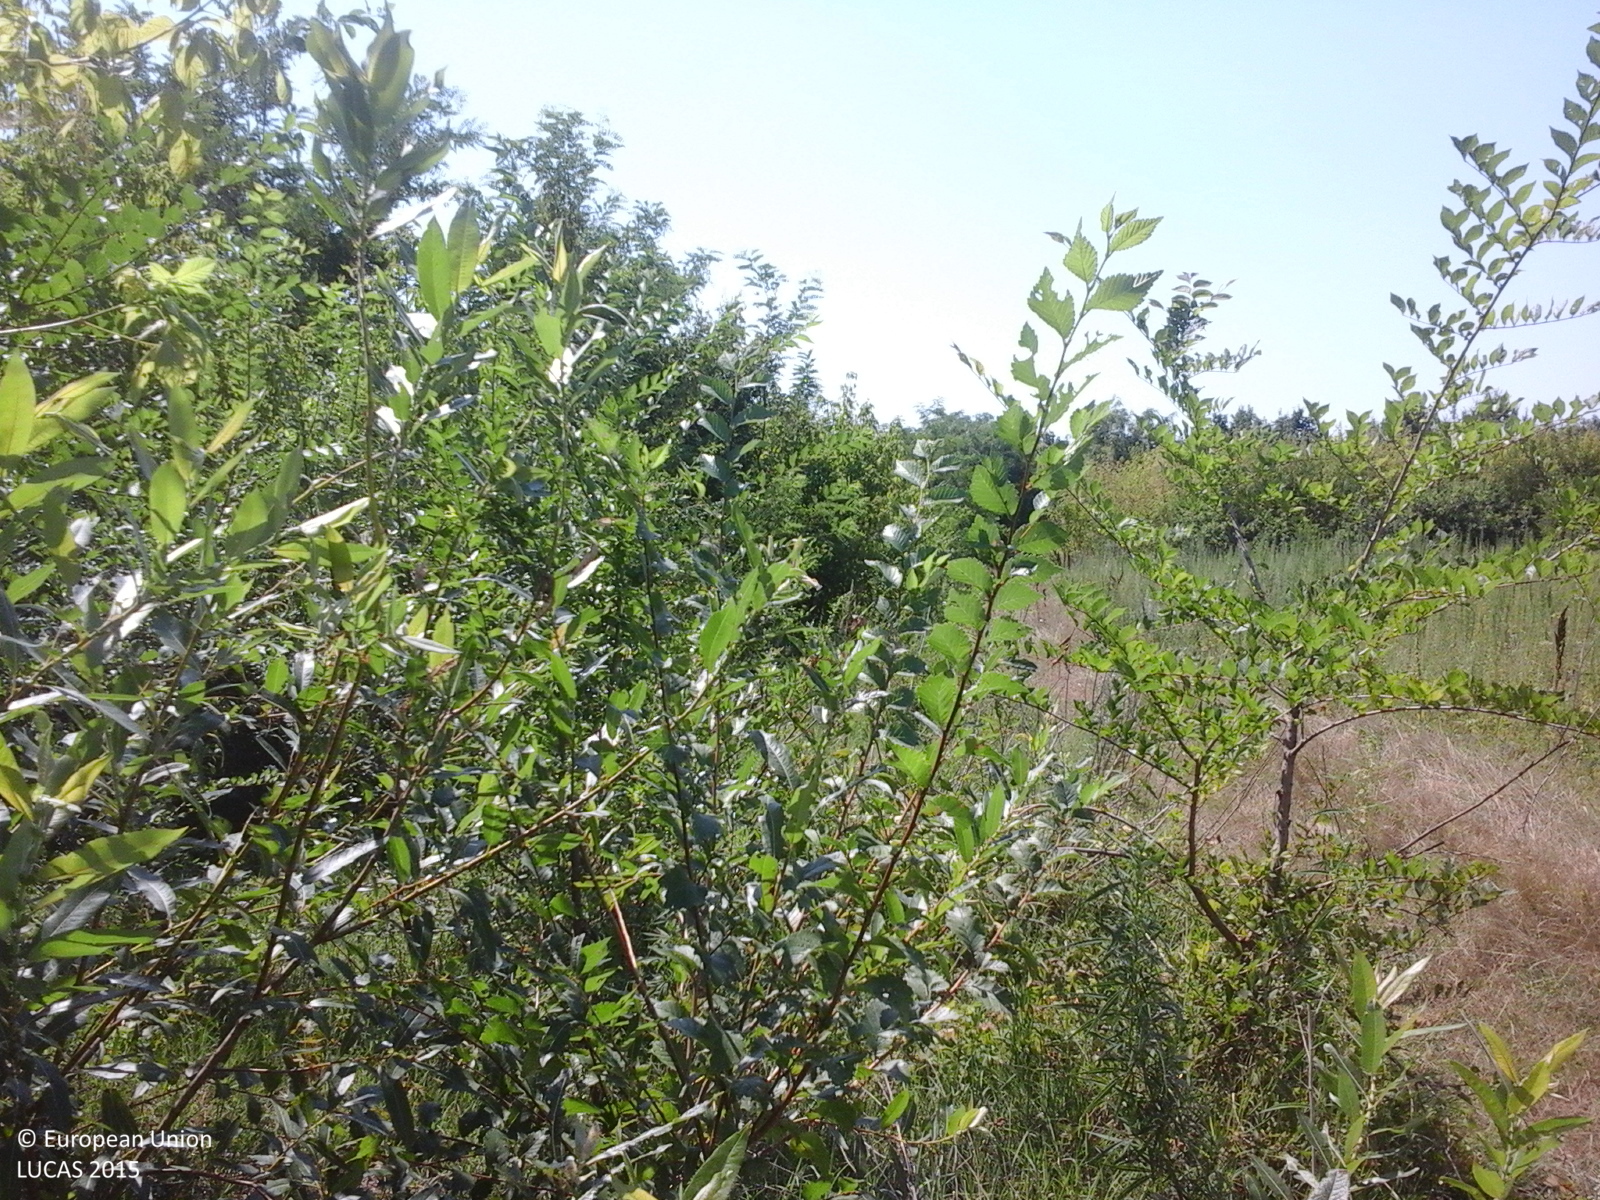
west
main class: Woodland
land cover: Broadleaved woodland
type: exotic forest
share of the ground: > 75 %
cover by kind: broadleaved forest trees 100 %
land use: Forestry
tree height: > 5 m
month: July
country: RO
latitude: 44.8653
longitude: 27.3422
